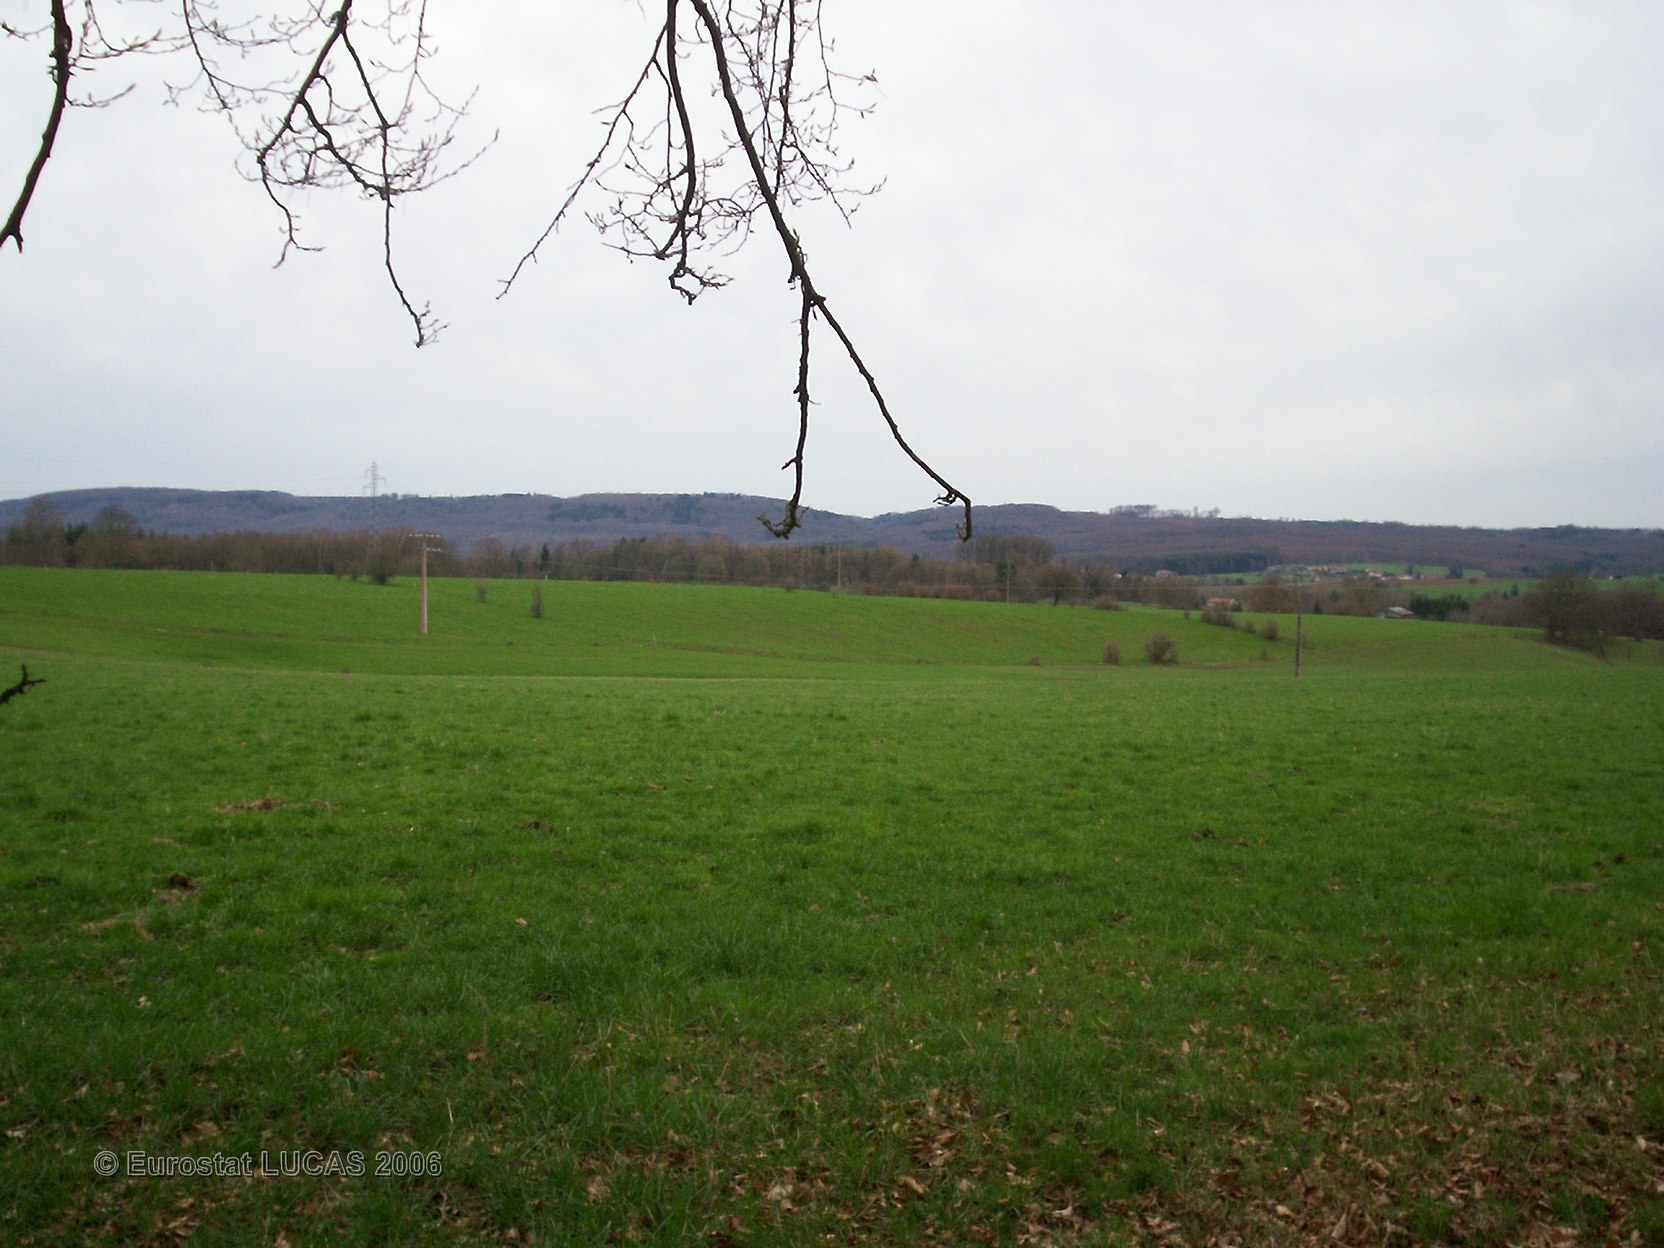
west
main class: Woodland
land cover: Broadleaved forest
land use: Forestry
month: April
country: FR
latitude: 48.0160
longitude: 6.2603
